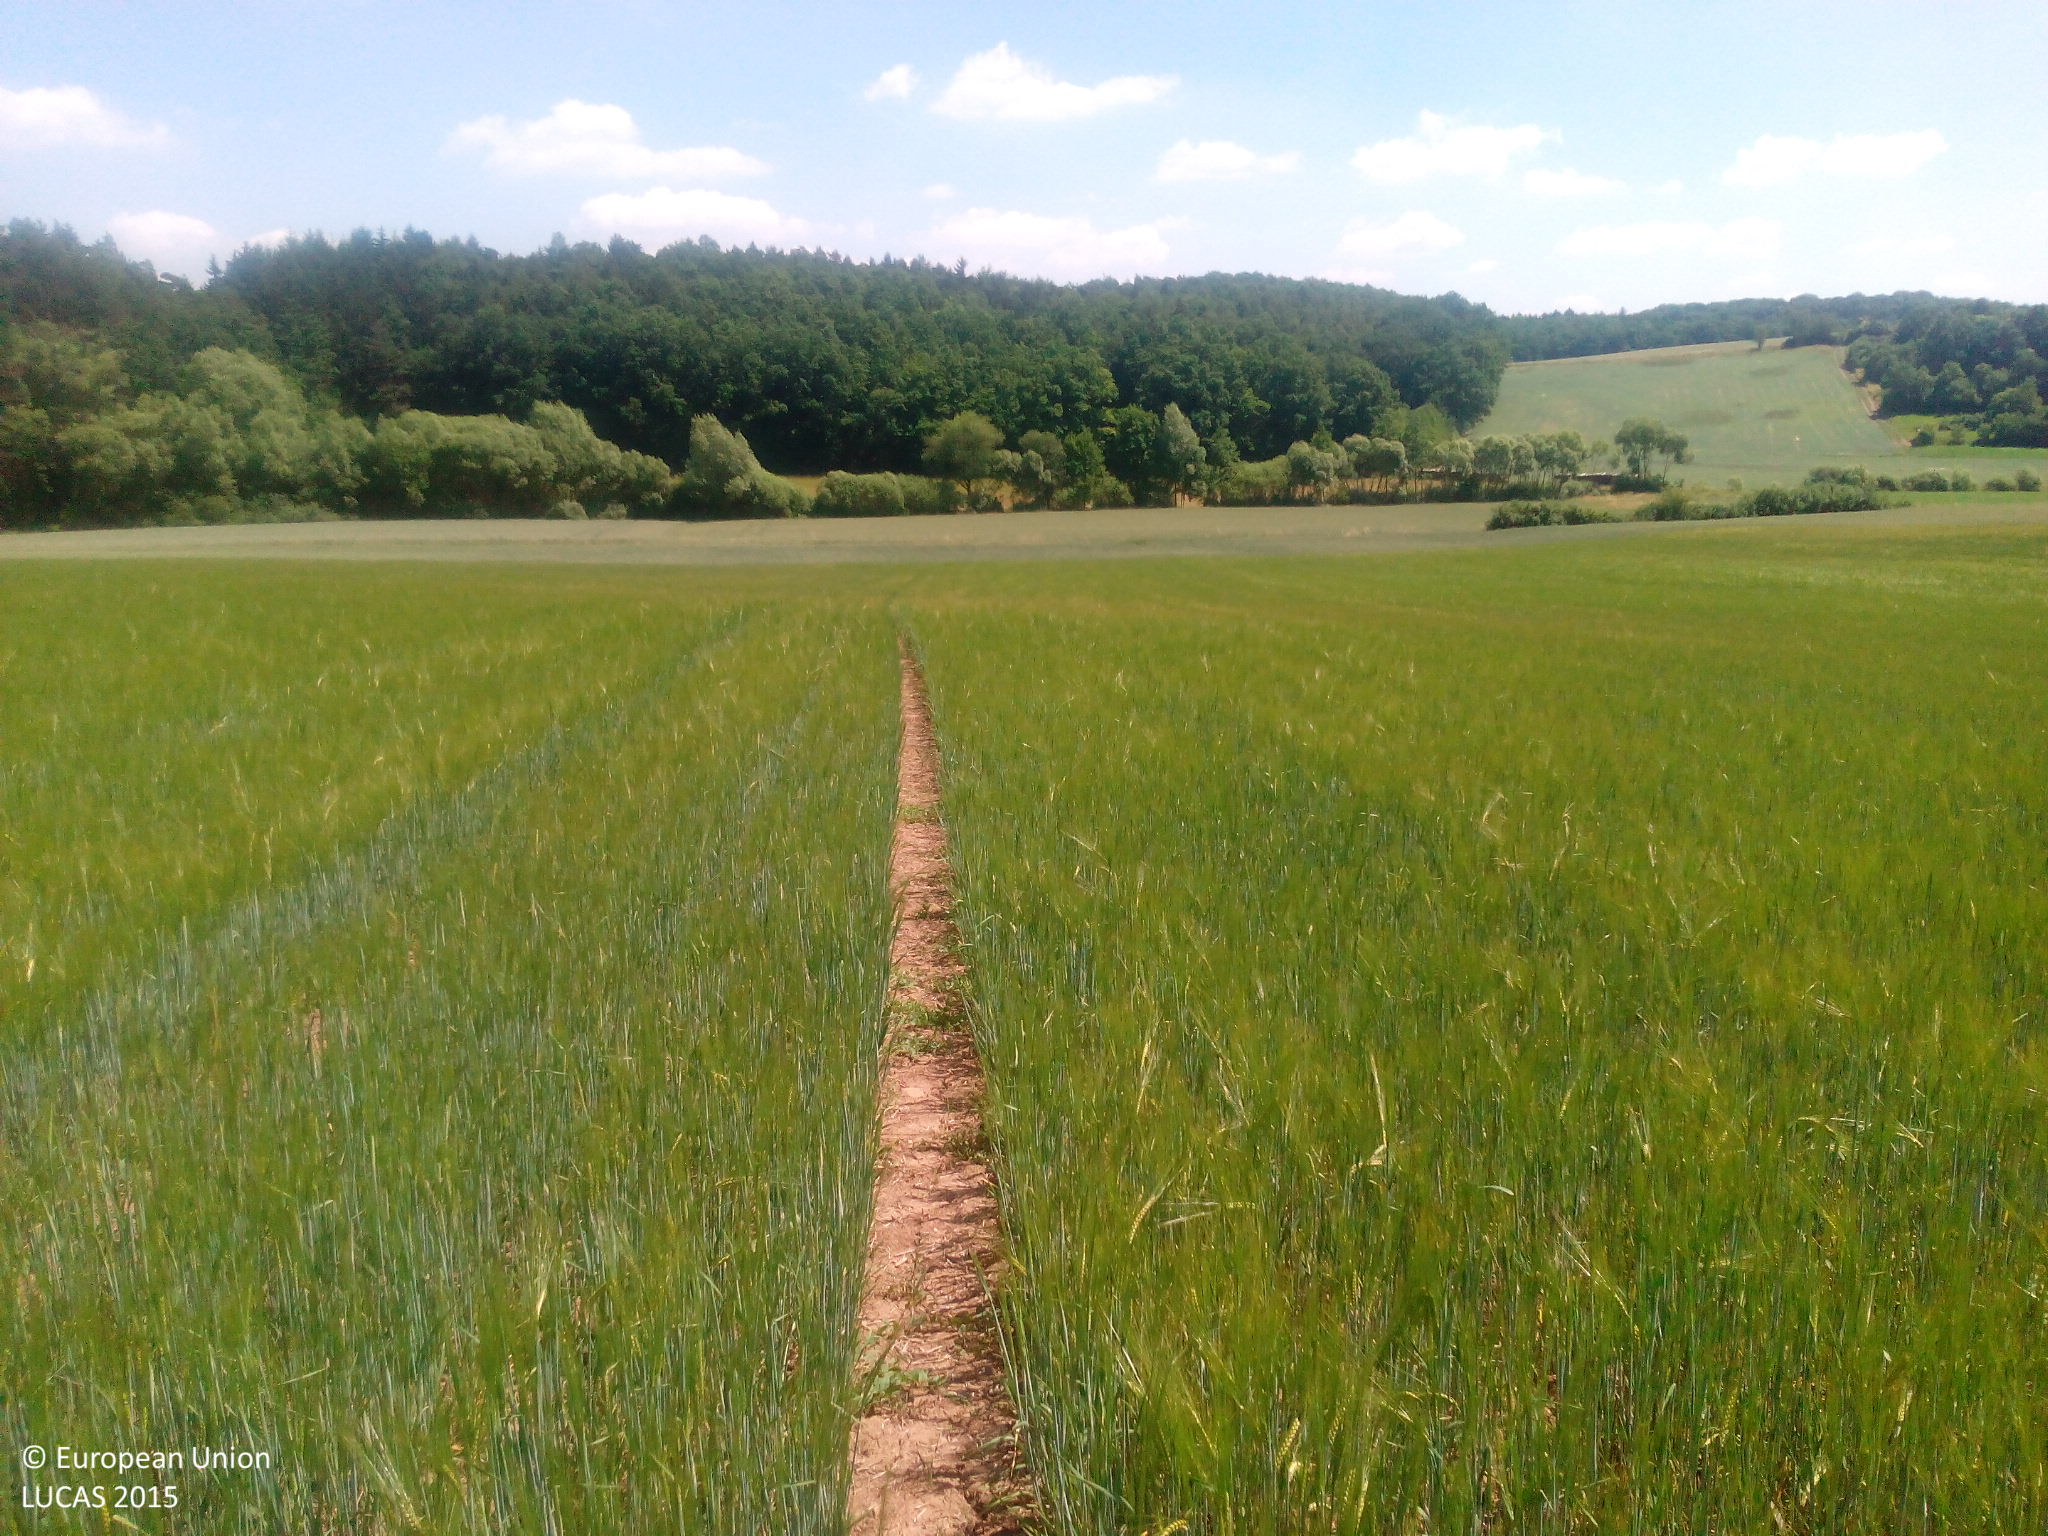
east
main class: Cropland
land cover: Barley
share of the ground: > 75 %
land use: Agriculture (excluding fallow land and kitchen gardens)
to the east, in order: Barley; Common wheat; Grass margins; Ditches and canals; Grass margins; Paved roads, cycling and walking lanes; Grass margins; Common wheat; Broadleaved woodland; Rivers and streams; Broadleaved woodland; Grassland without tree/shrub cover
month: June
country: DE
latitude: 50.2184
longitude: 10.6305
